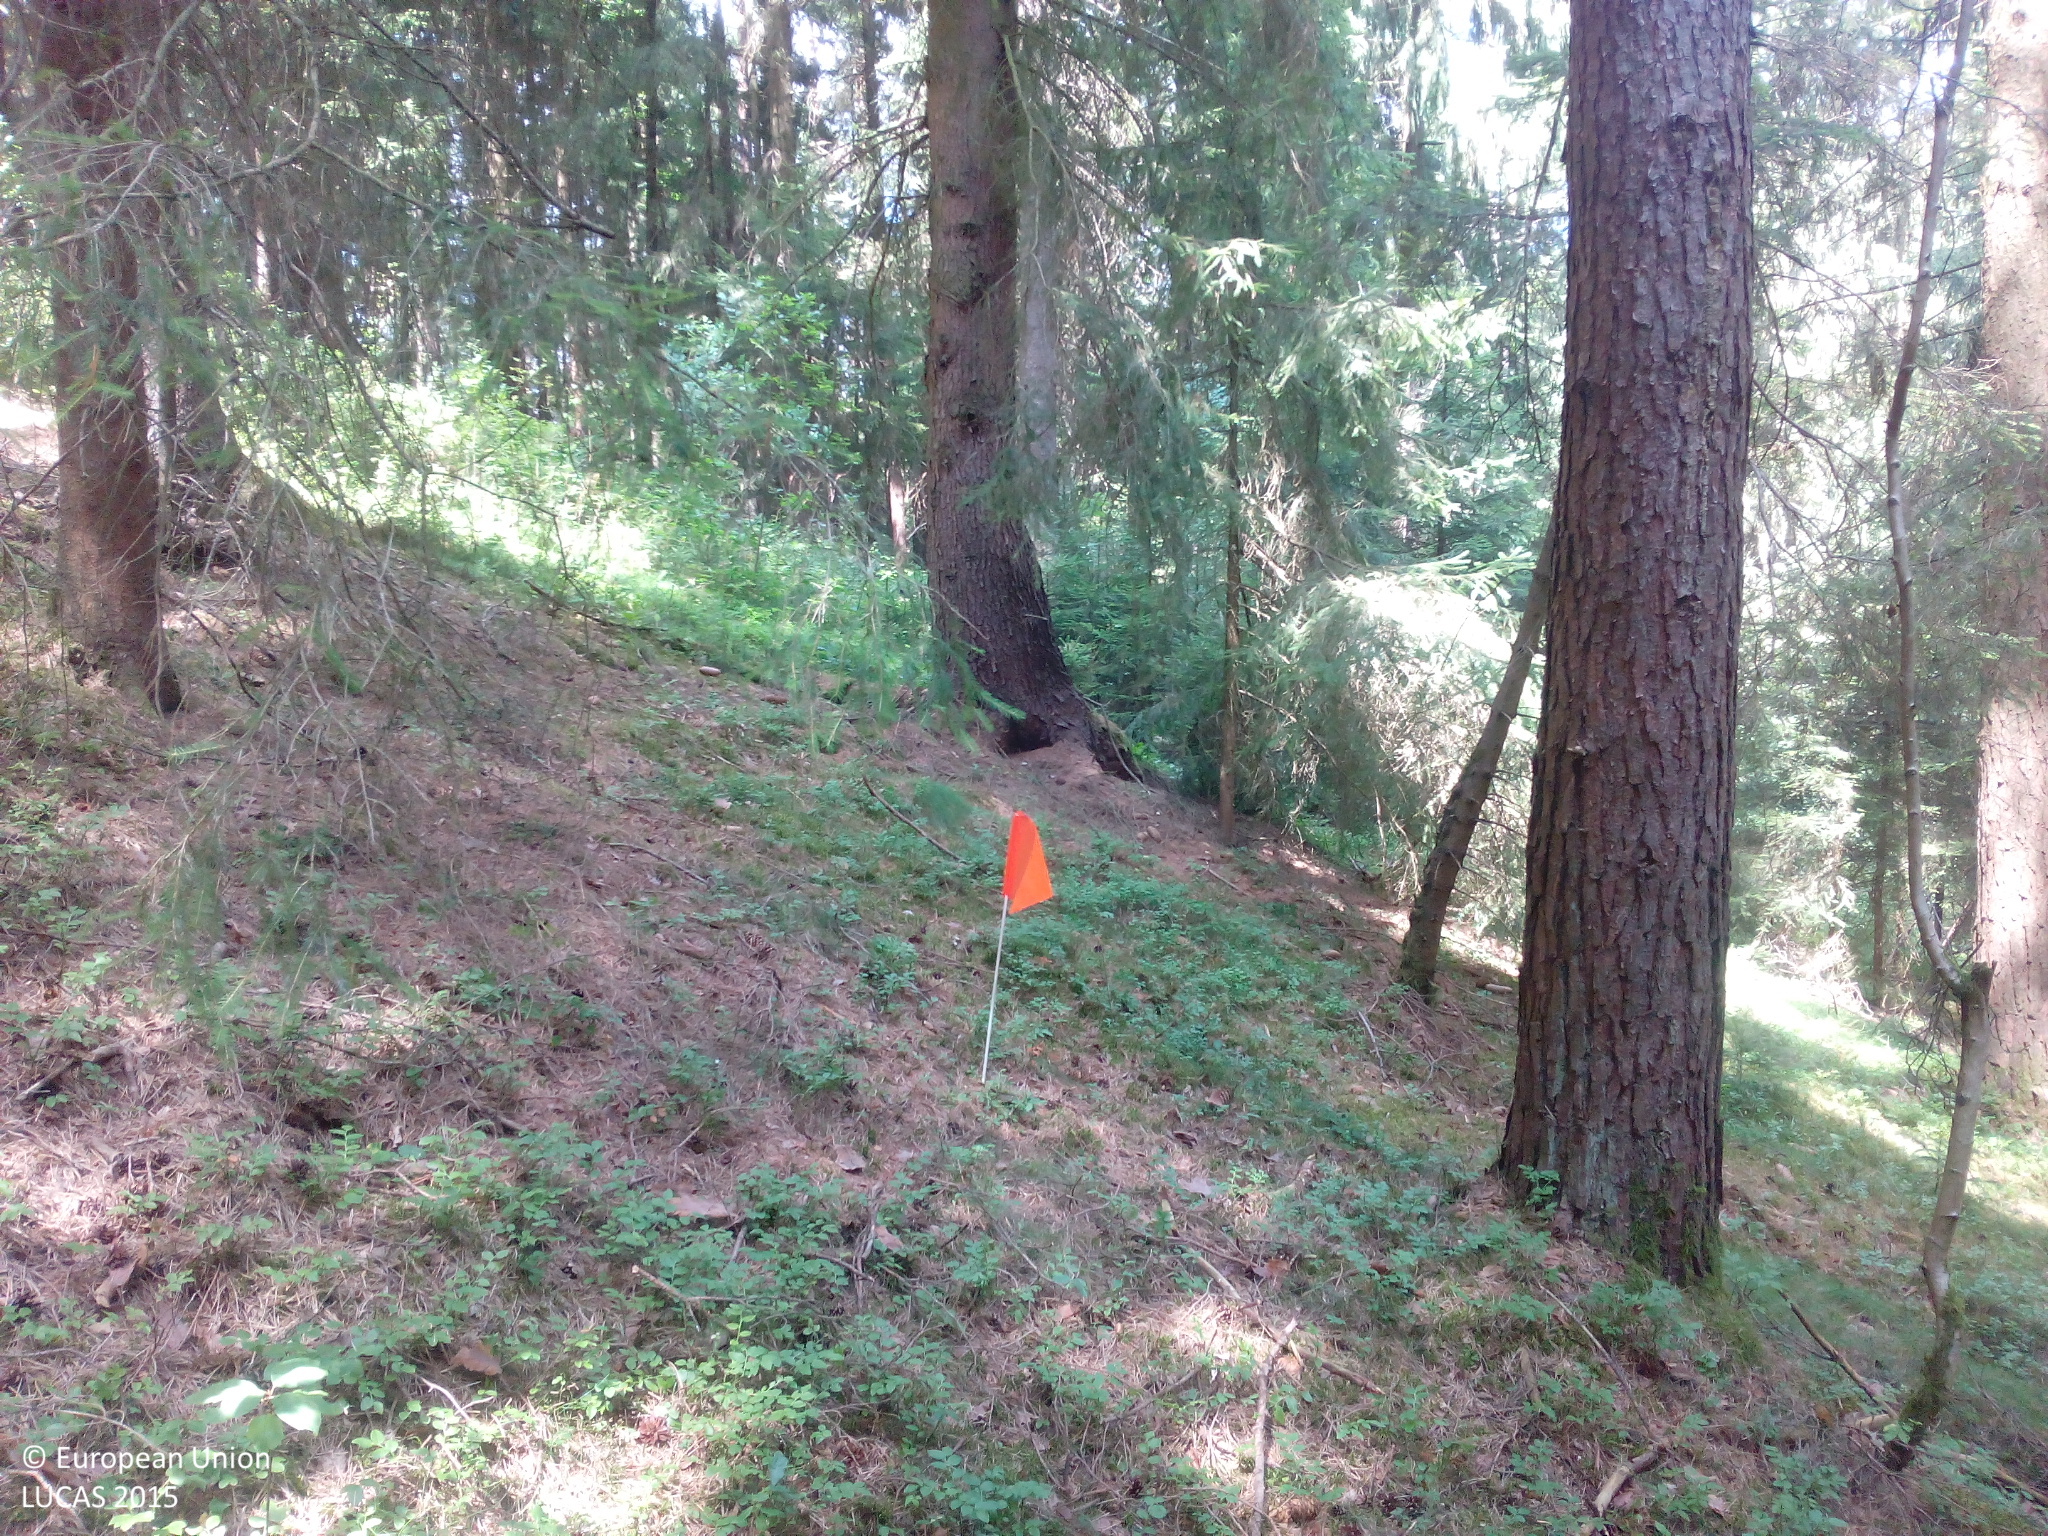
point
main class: Woodland
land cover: Spruce dominated coniferous woodland
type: hemiboreal forest and nemoral coniferous forest and mixed broadleaved-coniferous forest
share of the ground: > 75 %
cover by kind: coniferous forest trees 80 %, unconsolidated bare surface 10 %, shrubs 5 %, lichens and mosses 5 %
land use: Forestry
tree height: > 5 m
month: July
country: DE
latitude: 49.5868
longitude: 12.2266
